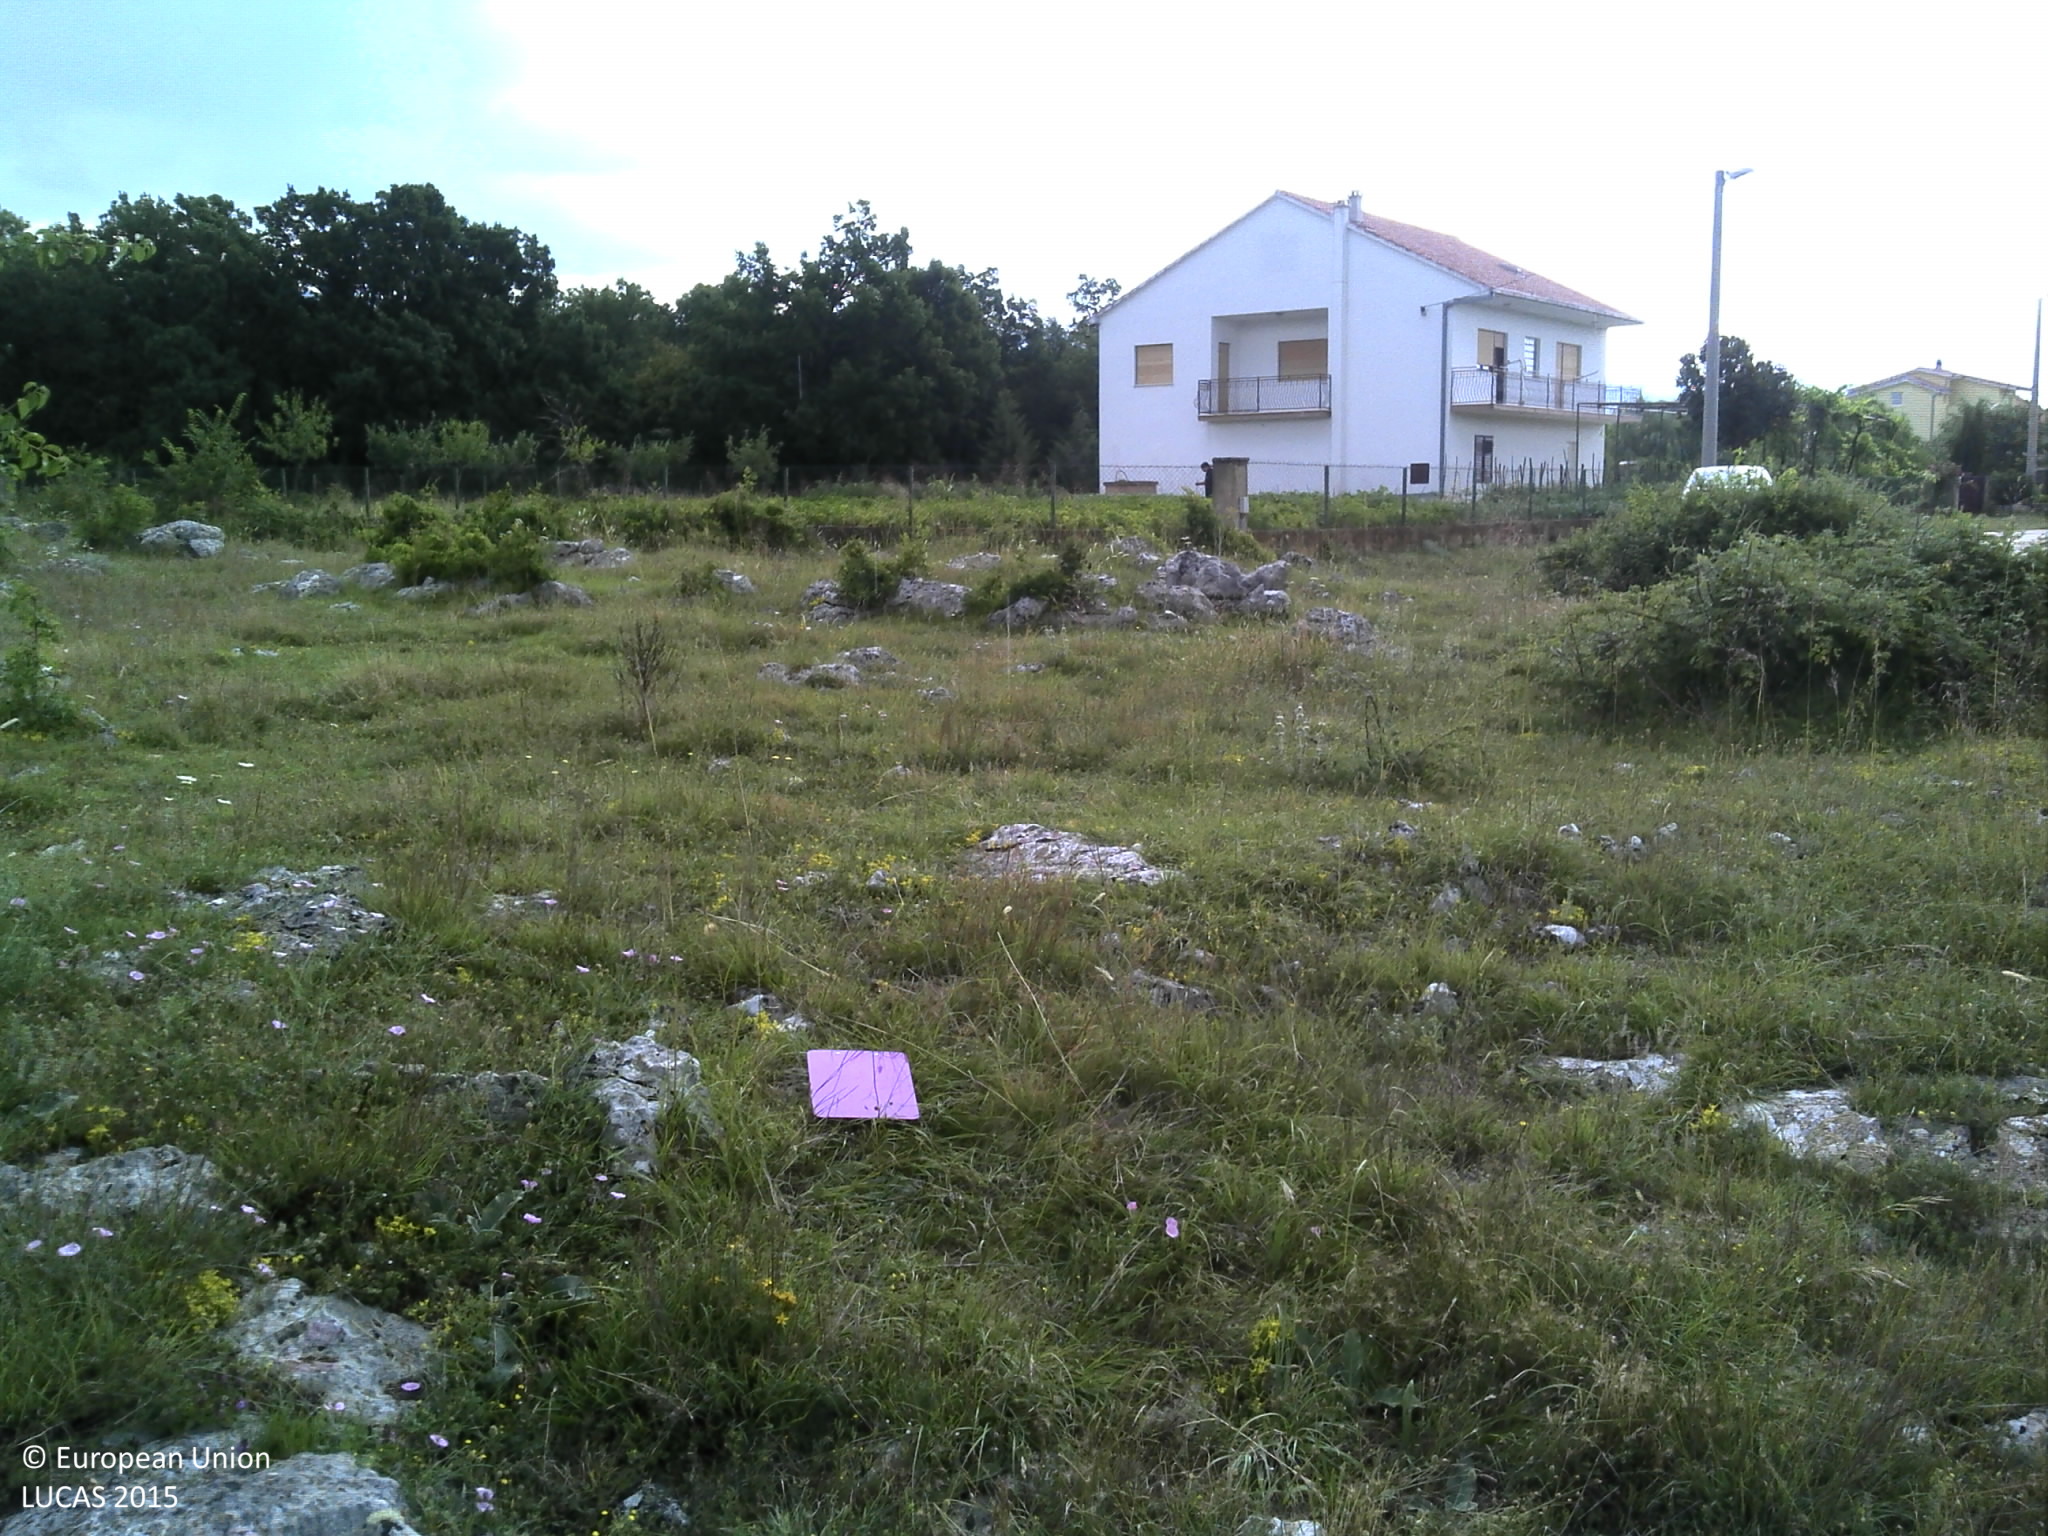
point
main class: Grassland
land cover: Grassland with sparse tree/shrub cover
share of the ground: 50 - 75 %
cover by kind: herbaceous plants 65 %, unconsolidated bare surface 20 %, broadleaved forest trees 5 %, shrubs 5 %, consolidated bare surface 5 %
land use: Abandoned areas
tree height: > 5 m
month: June
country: HR
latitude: 43.7955
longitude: 16.6165
